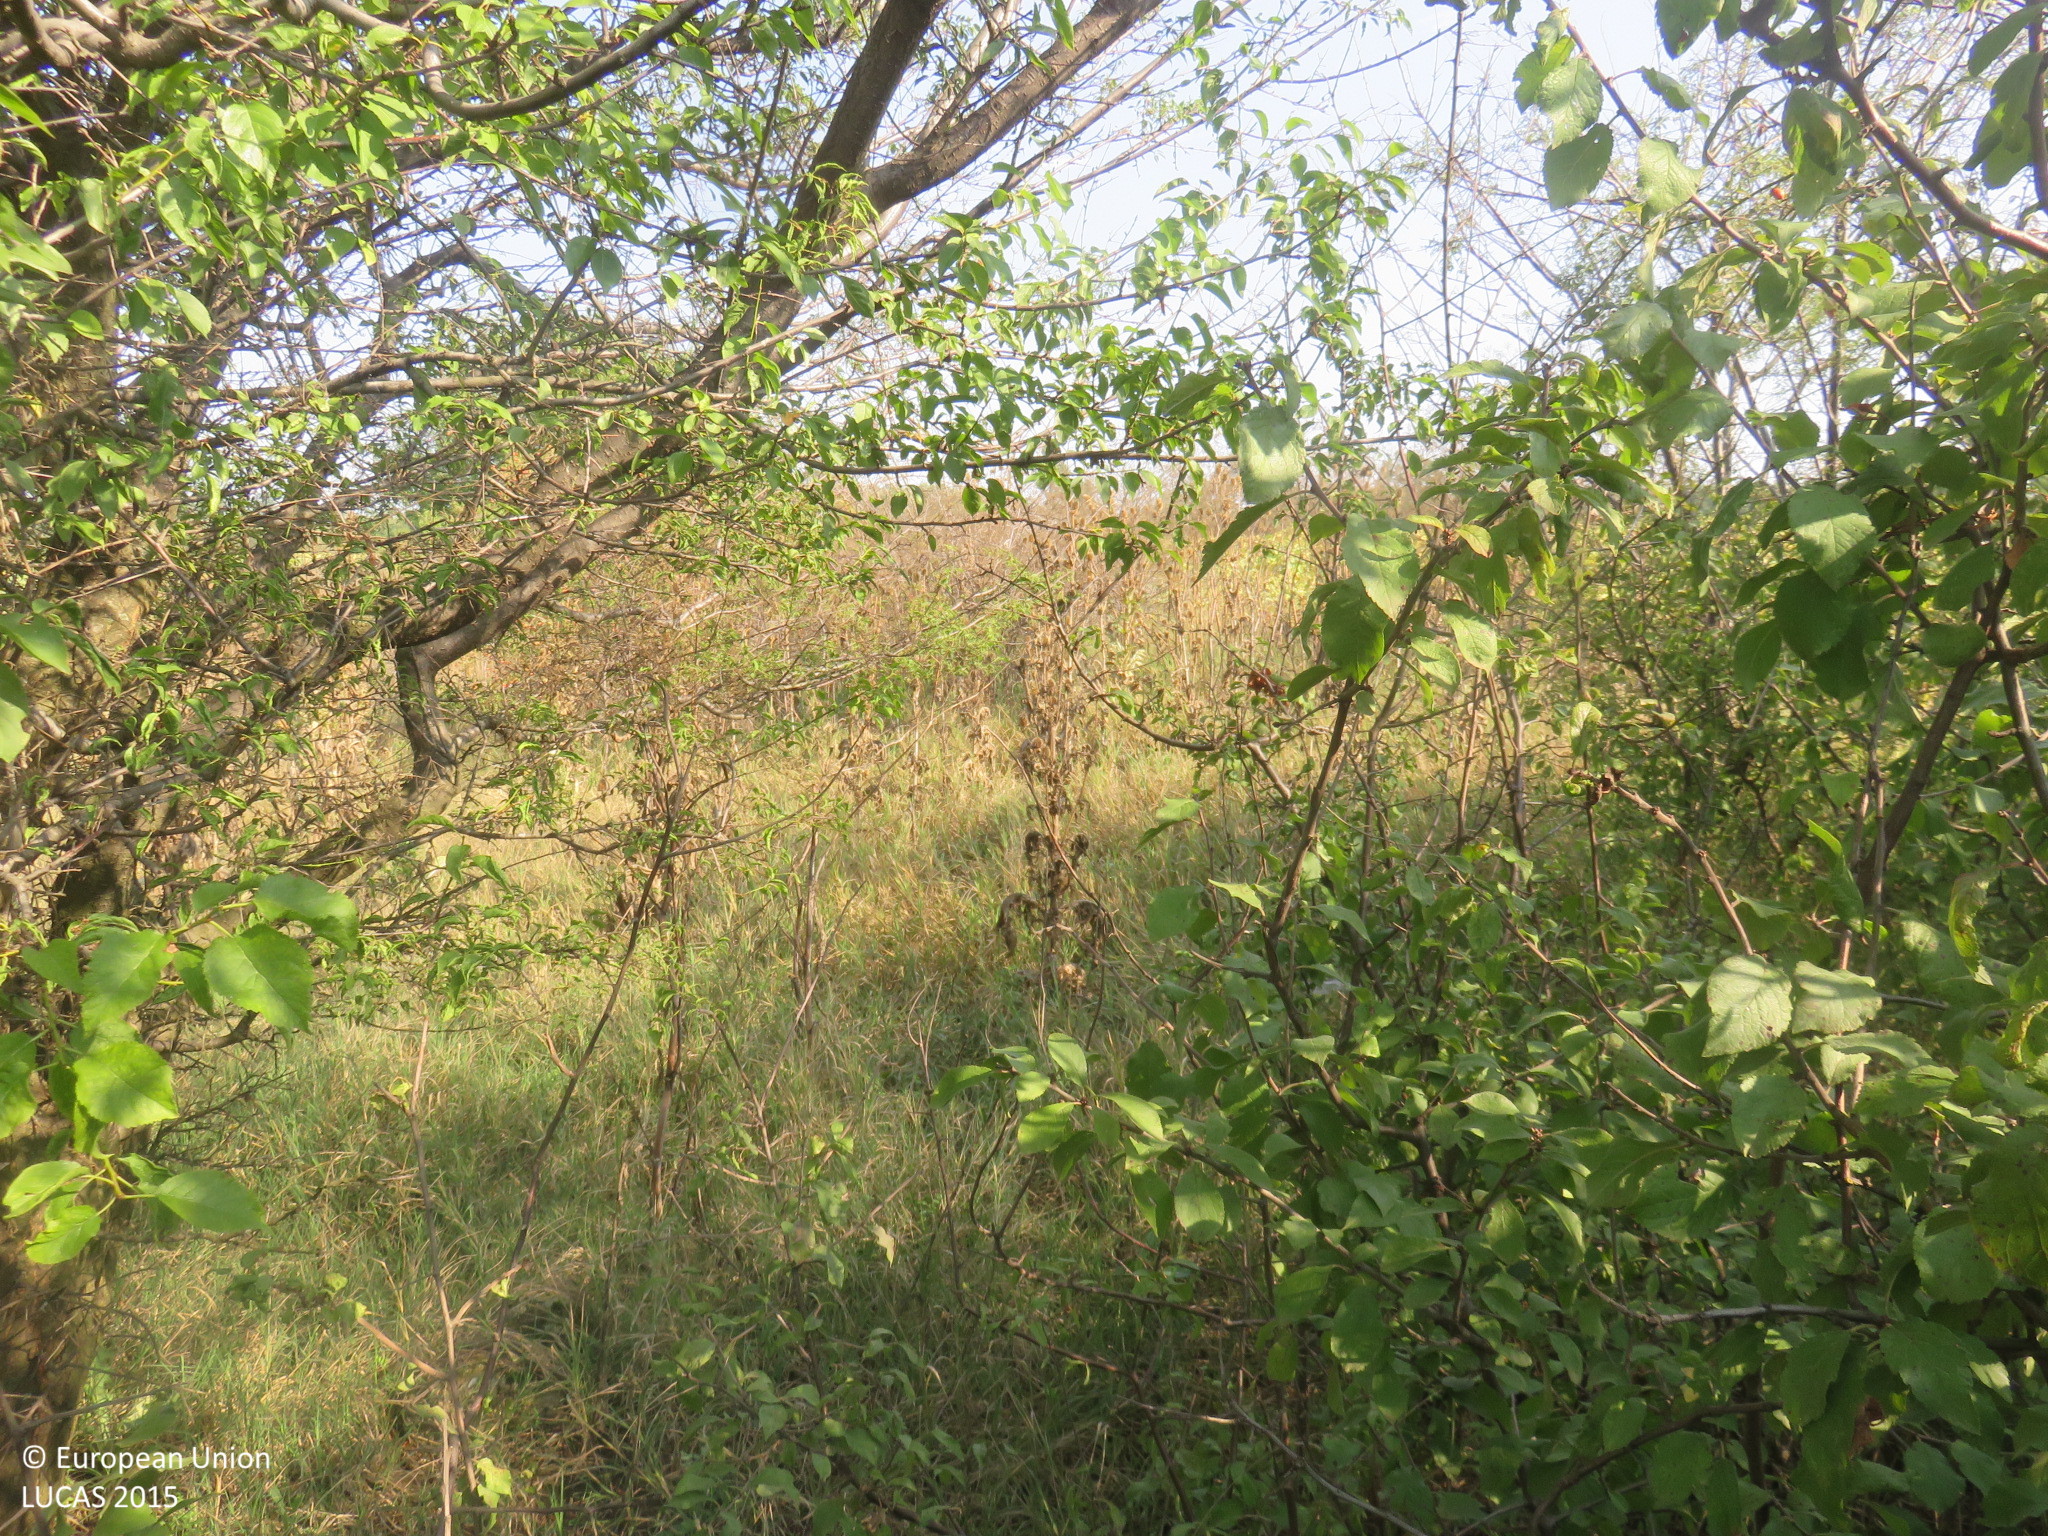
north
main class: Shrubland
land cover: Shrubland with sparse tree cover
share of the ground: > 75 %
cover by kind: shrubs 95 %, broadleaved forest trees 5 %
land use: Semi-natural and natural areas not in use
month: September
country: BG
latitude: 43.1633
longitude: 24.9865
